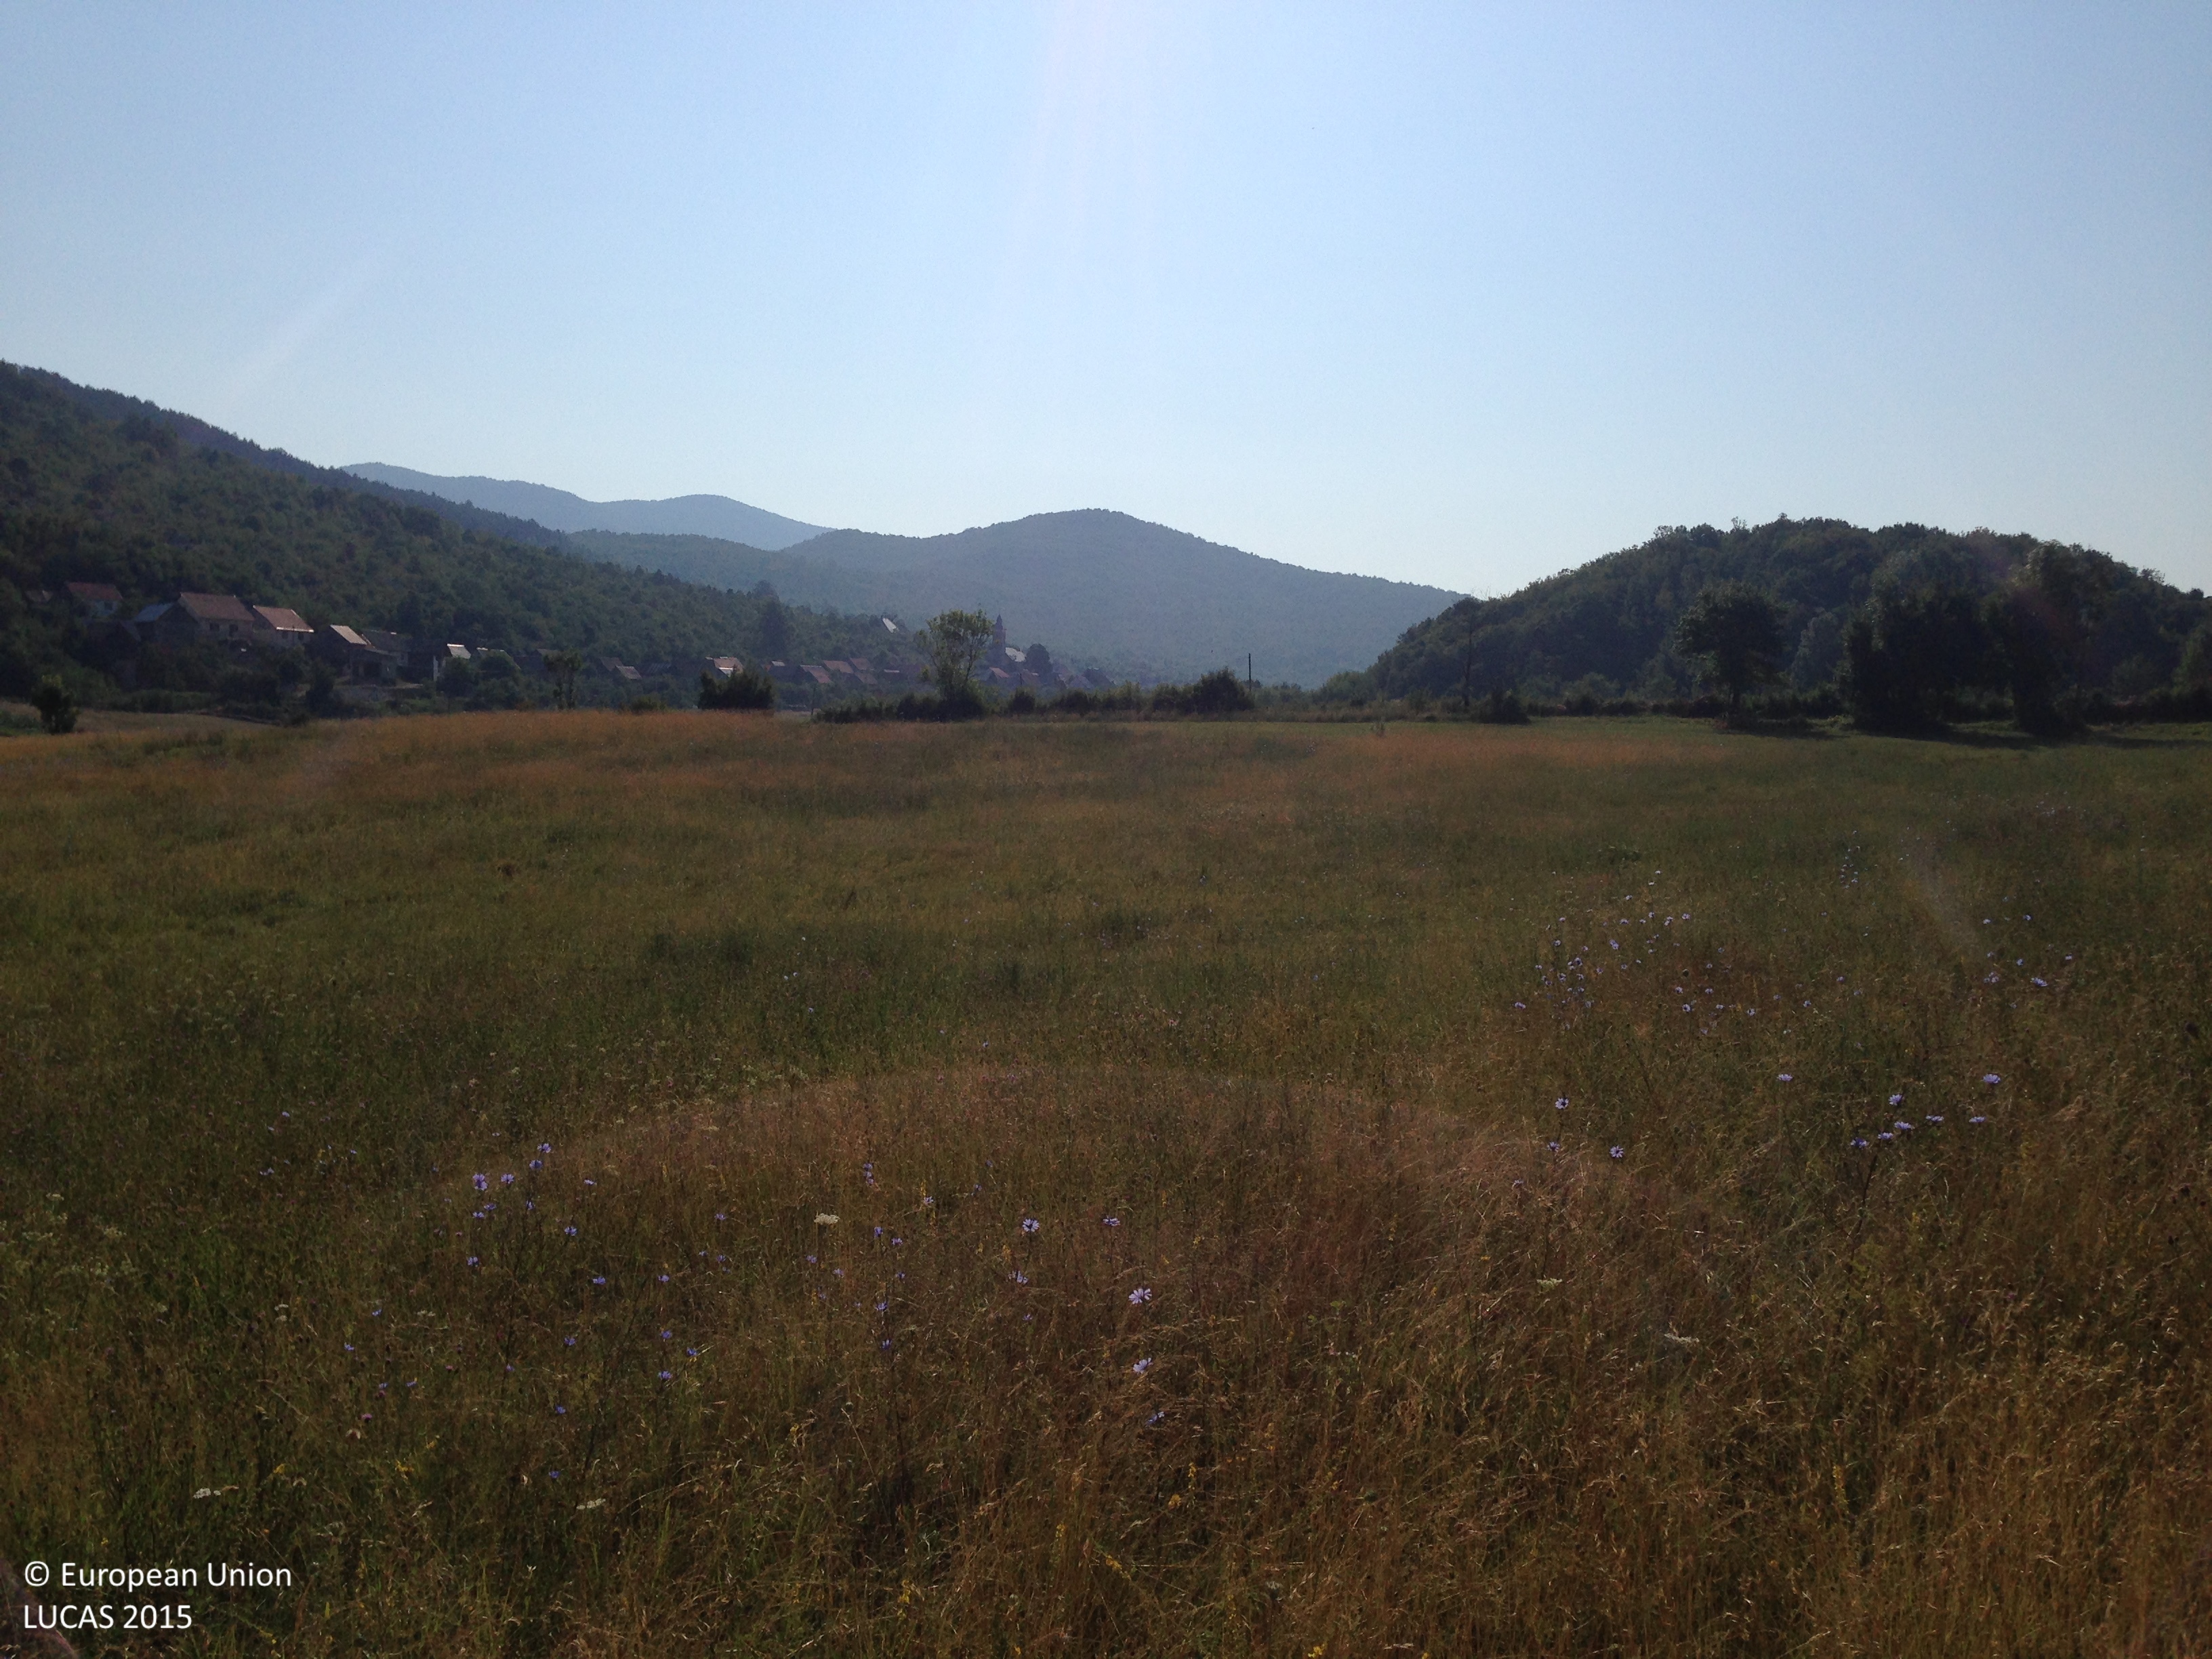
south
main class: Grassland
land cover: Grassland without tree/shrub cover
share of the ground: > 75 %
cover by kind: herbaceous plants 95 %, shrubs 5 %
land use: Agriculture (excluding fallow land and kitchen gardens)
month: July
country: HR
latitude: 44.7604
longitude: 15.2367
